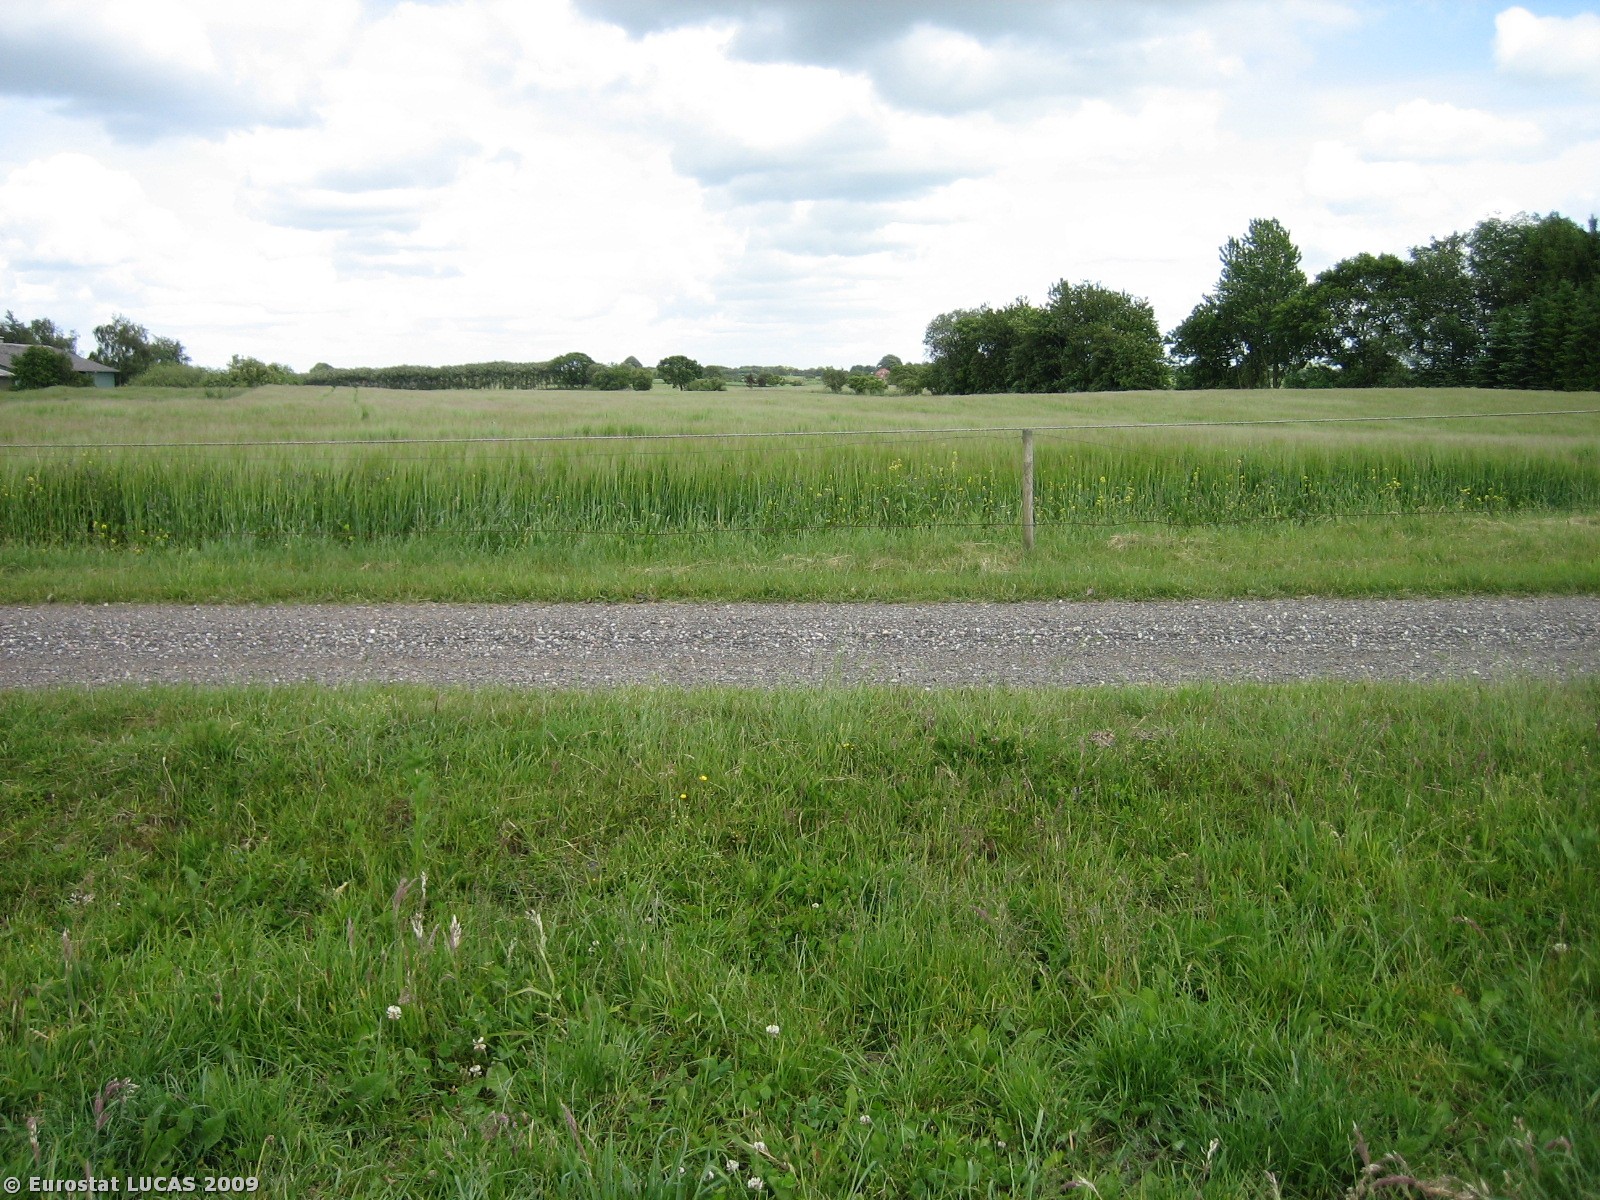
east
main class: Grassland
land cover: Grassland without tree/shrub cover
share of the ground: > 75 %
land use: Agriculture (excluding fallow land and kitchen gardens)
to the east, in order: Grassland without tree/shrub cover; Fences; Tracks; Grass margins; Fences; Barley
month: June
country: DK
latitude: 55.6285
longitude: 9.2860
